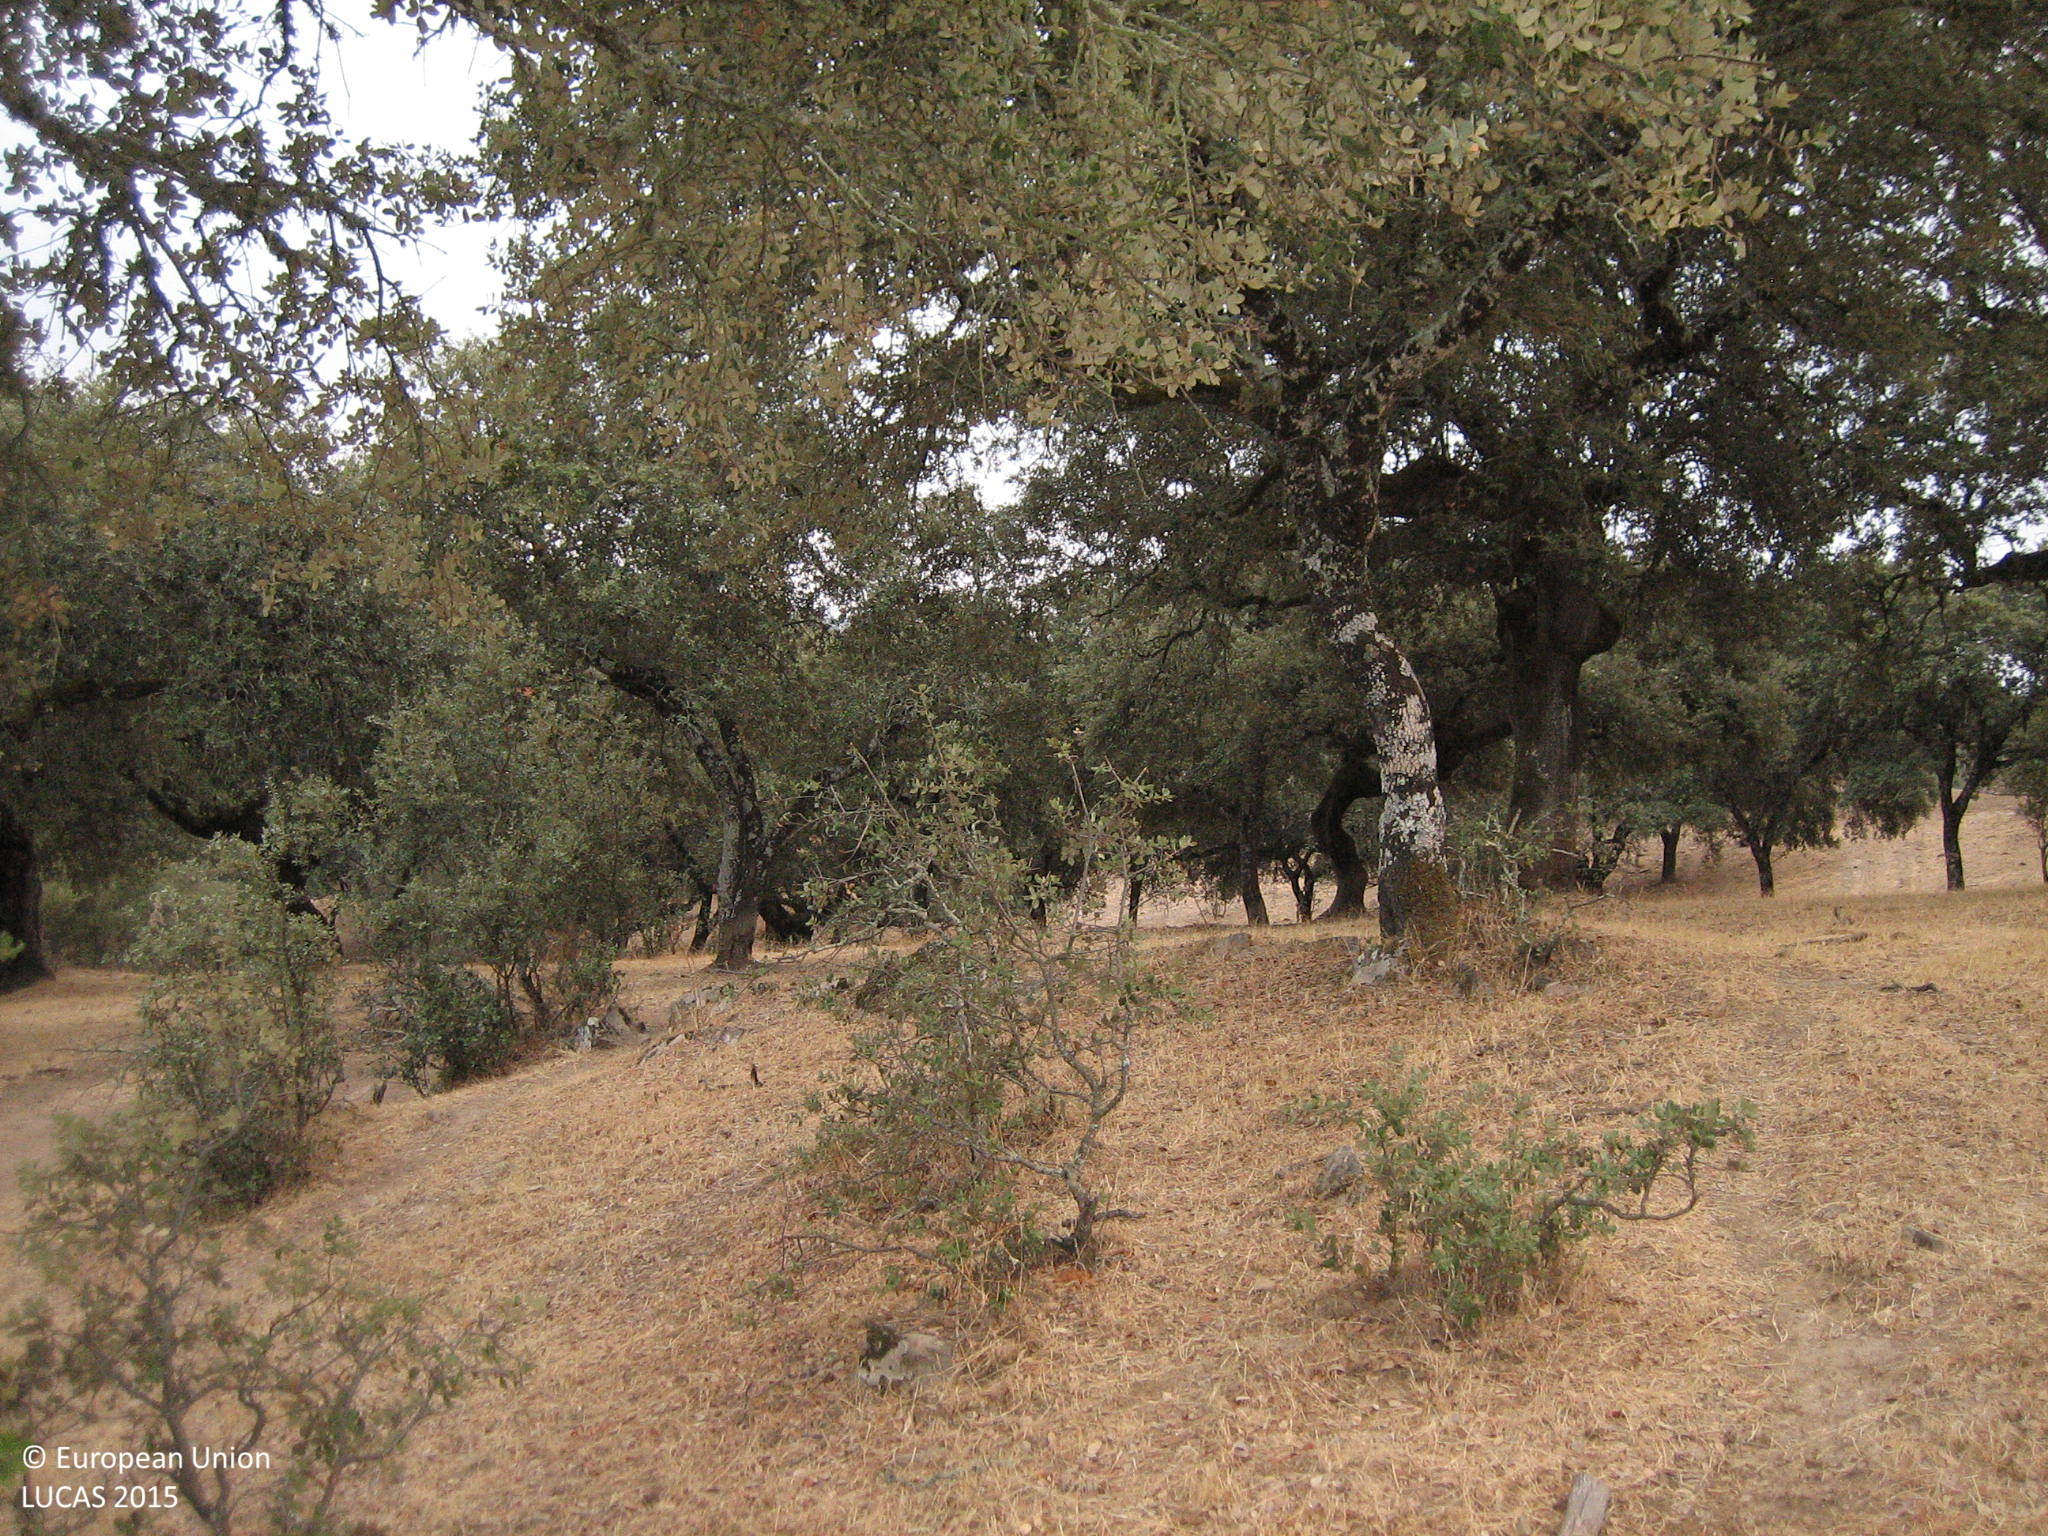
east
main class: Woodland
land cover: Broadleaved woodland
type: broadleaved evergreen forest
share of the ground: 25 - 50 %
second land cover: Grassland without tree/shrub cover
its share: > 75 %
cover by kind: herbaceous plants 55 %, broadleaved forest trees 40 %, shrubs 5 %
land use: Forestry
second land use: Agriculture (excluding fallow land and kitchen gardens)
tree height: > 5 m
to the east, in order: Broadleaved woodland; Grassland without tree/shrub cover; Rivers and streams; Broadleaved woodland
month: September
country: ES
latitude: 38.3386
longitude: -6.8409
